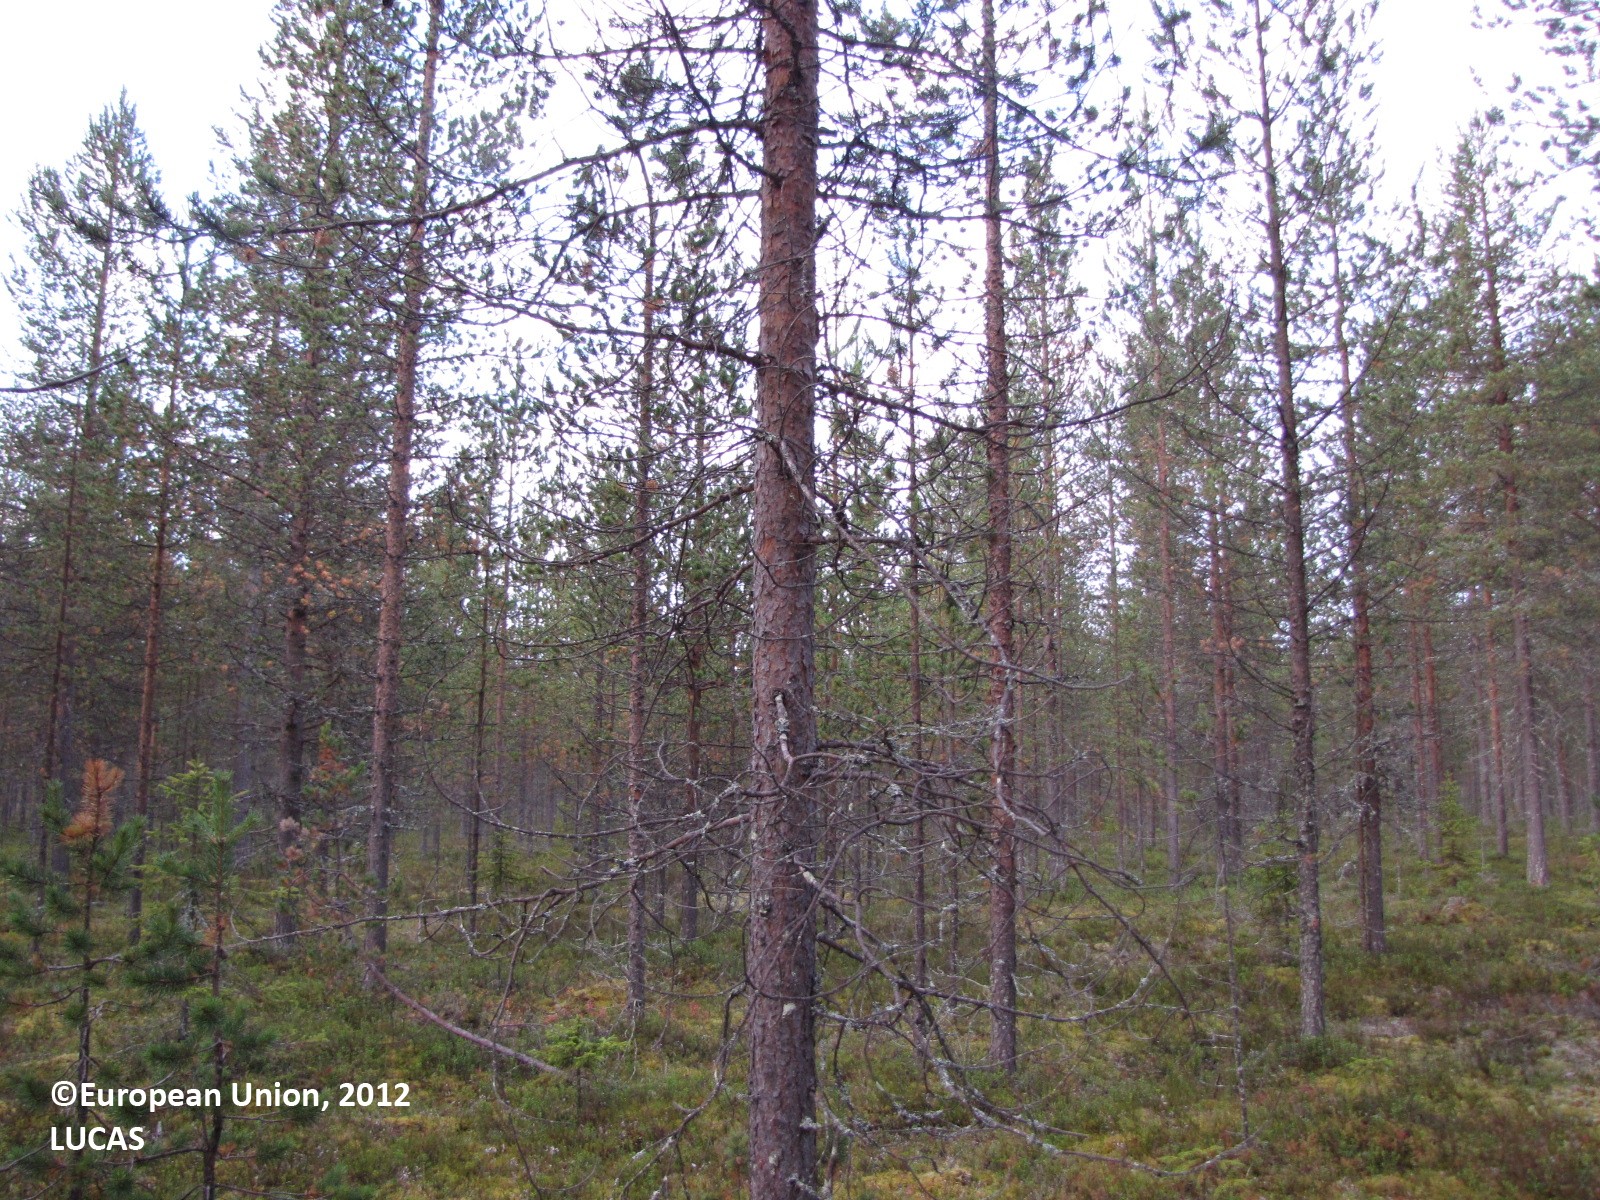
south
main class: Woodland
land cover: Pine dominated coniferous woodland
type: boreal forest
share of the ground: 50 - 75 %
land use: Forestry
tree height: > 5 m
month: September
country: FI
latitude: 67.3139
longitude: 24.8870
